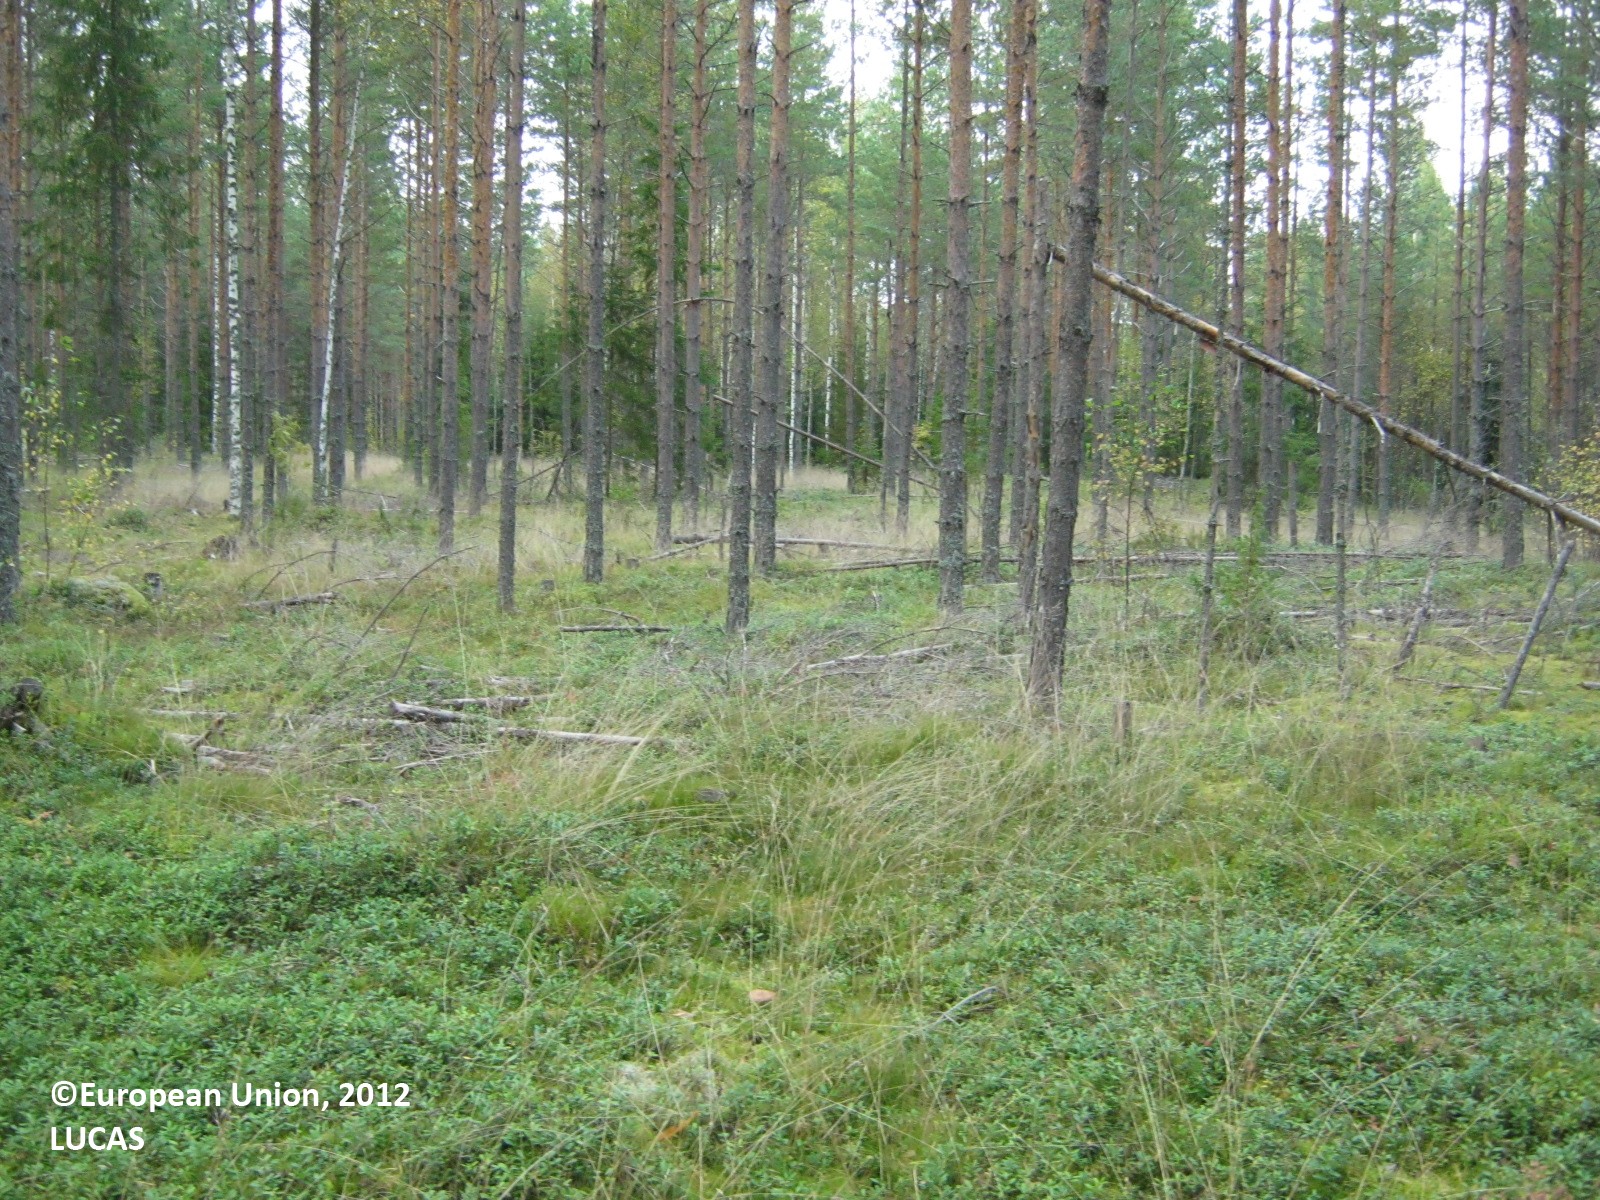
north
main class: Woodland
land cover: Pine dominated coniferous woodland
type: boreal forest
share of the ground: 50 - 75 %
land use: Forestry
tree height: > 5 m
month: September
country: FI
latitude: 60.8006
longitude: 28.0452
